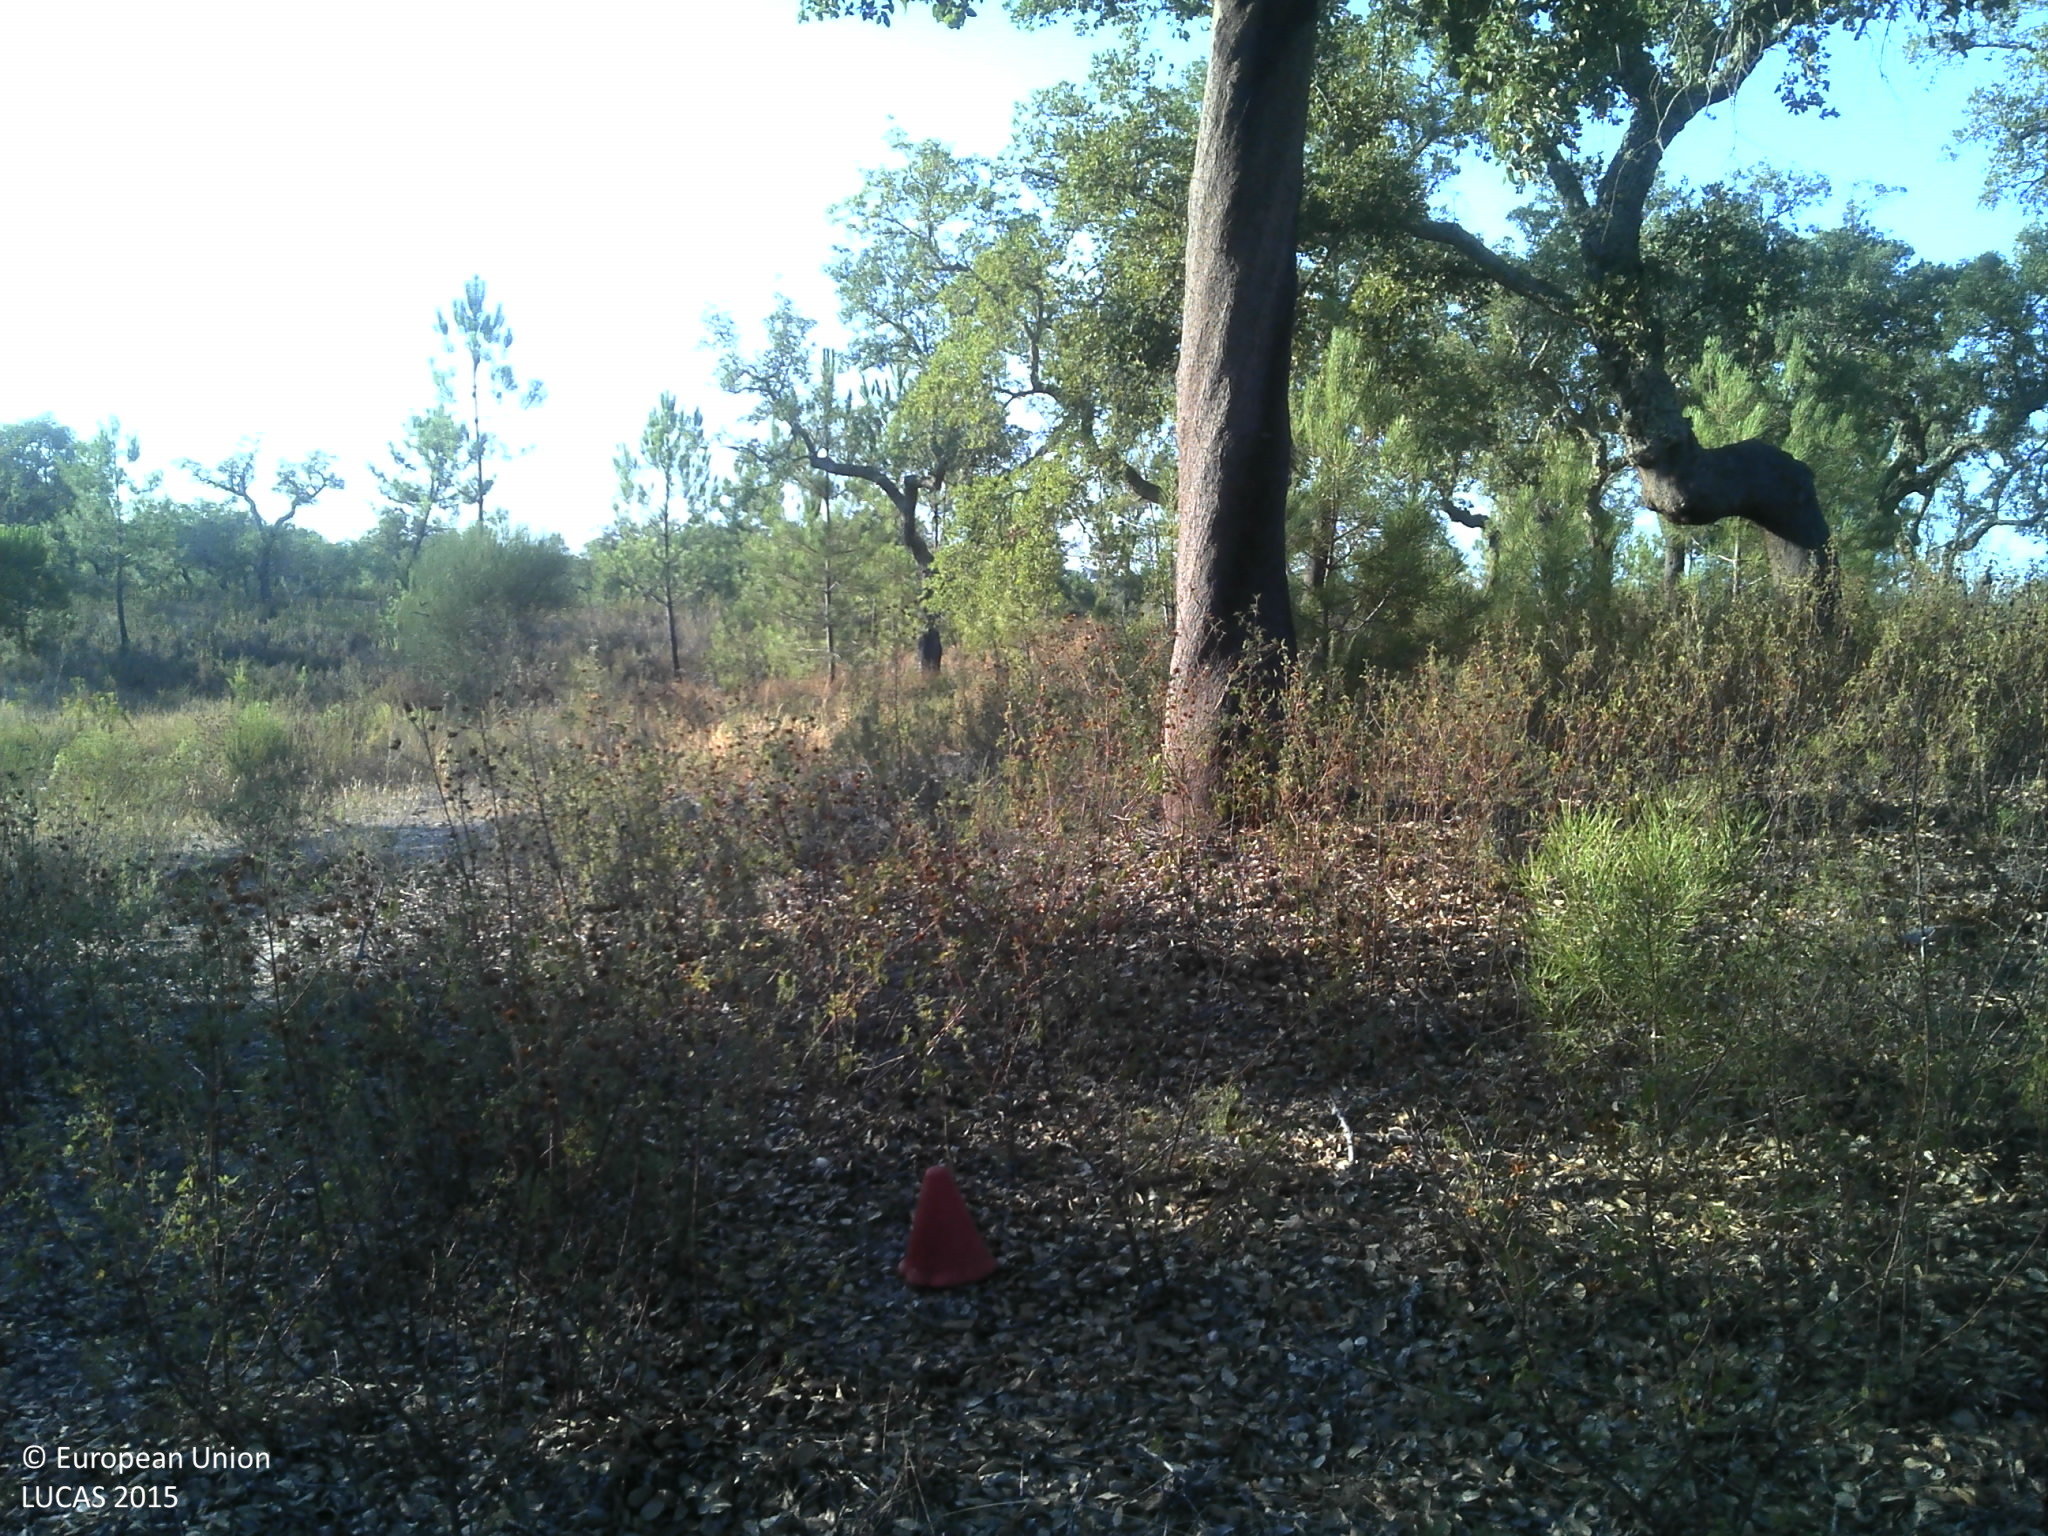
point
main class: Woodland
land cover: Broadleaved woodland
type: broadleaved evergreen forest
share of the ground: 25 - 50 %
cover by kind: broadleaved forest trees 50 %, unconsolidated bare surface 25 %, herbaceous plants 15 %, shrubs 10 %
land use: Forestry
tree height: > 5 m
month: July
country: PT
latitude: 38.9370
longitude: -8.2007
